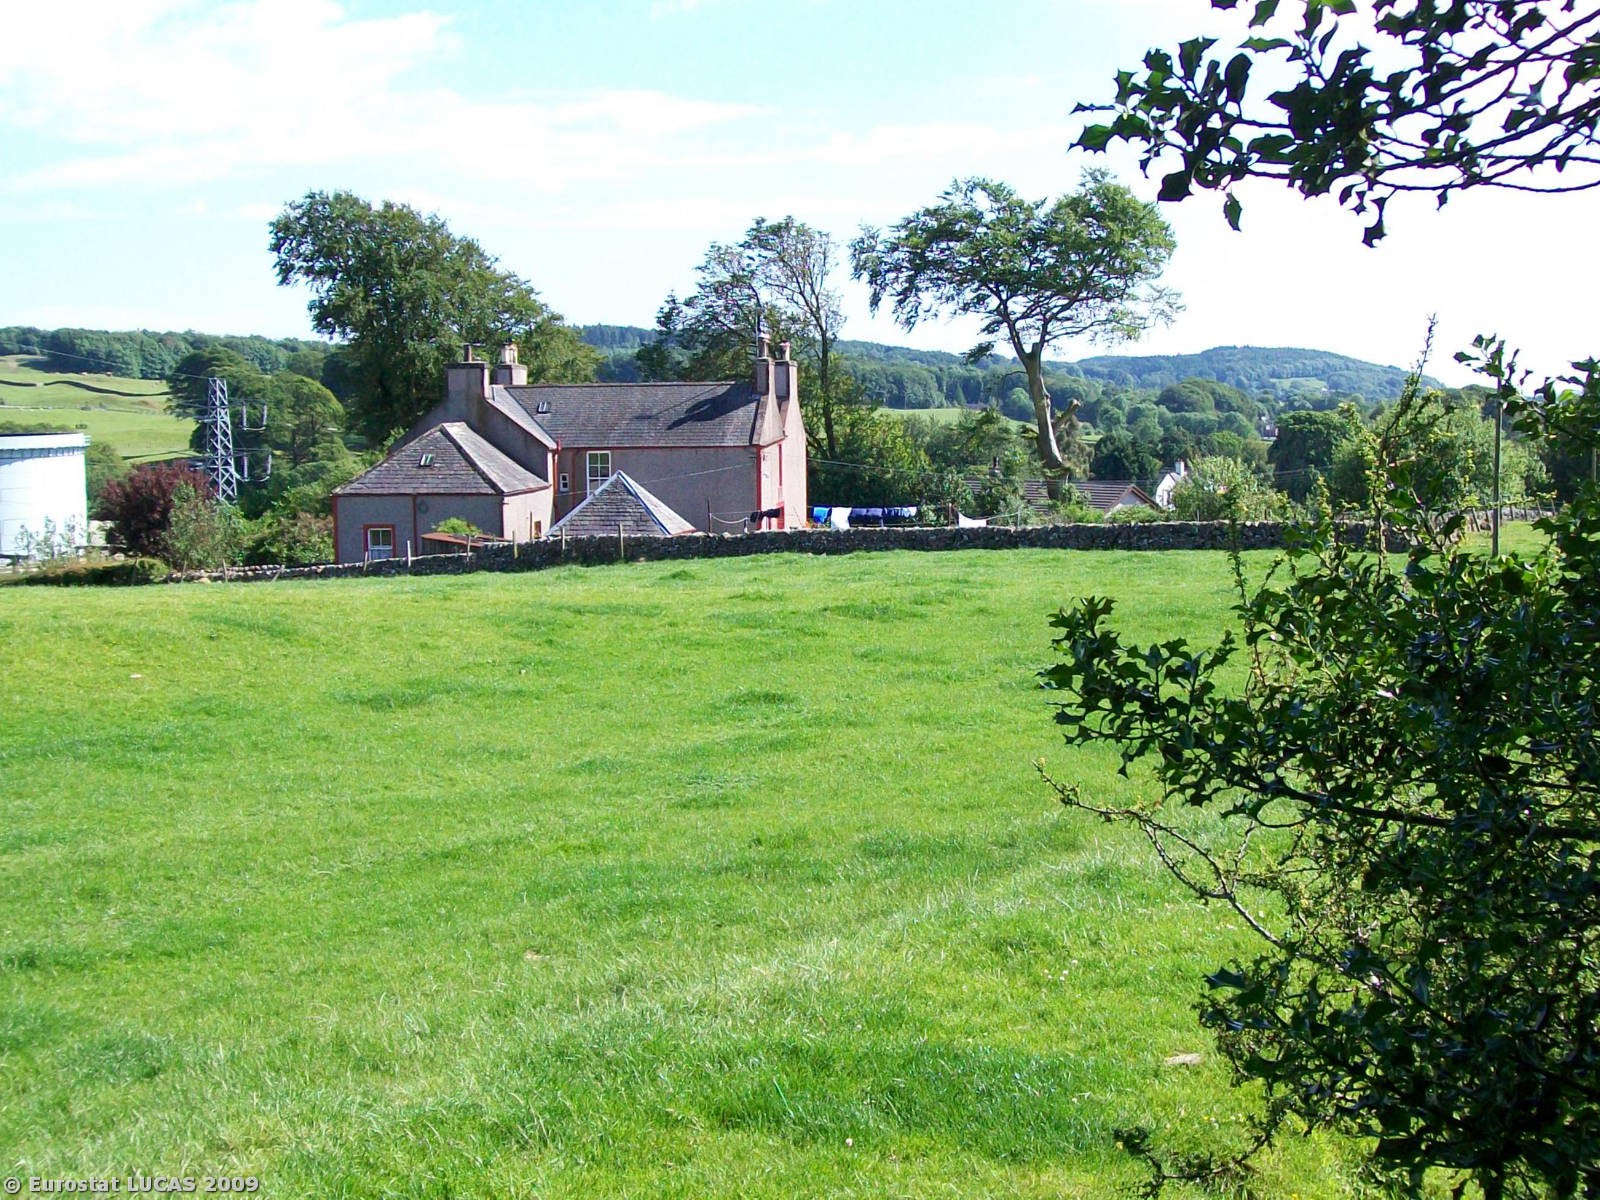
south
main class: Woodland
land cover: Broadleaved woodland
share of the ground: > 75 %
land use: Agriculture (excluding fallow land and kitchen gardens)
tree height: > 5 m
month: June
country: GB
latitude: 54.8626
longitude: -4.0358
